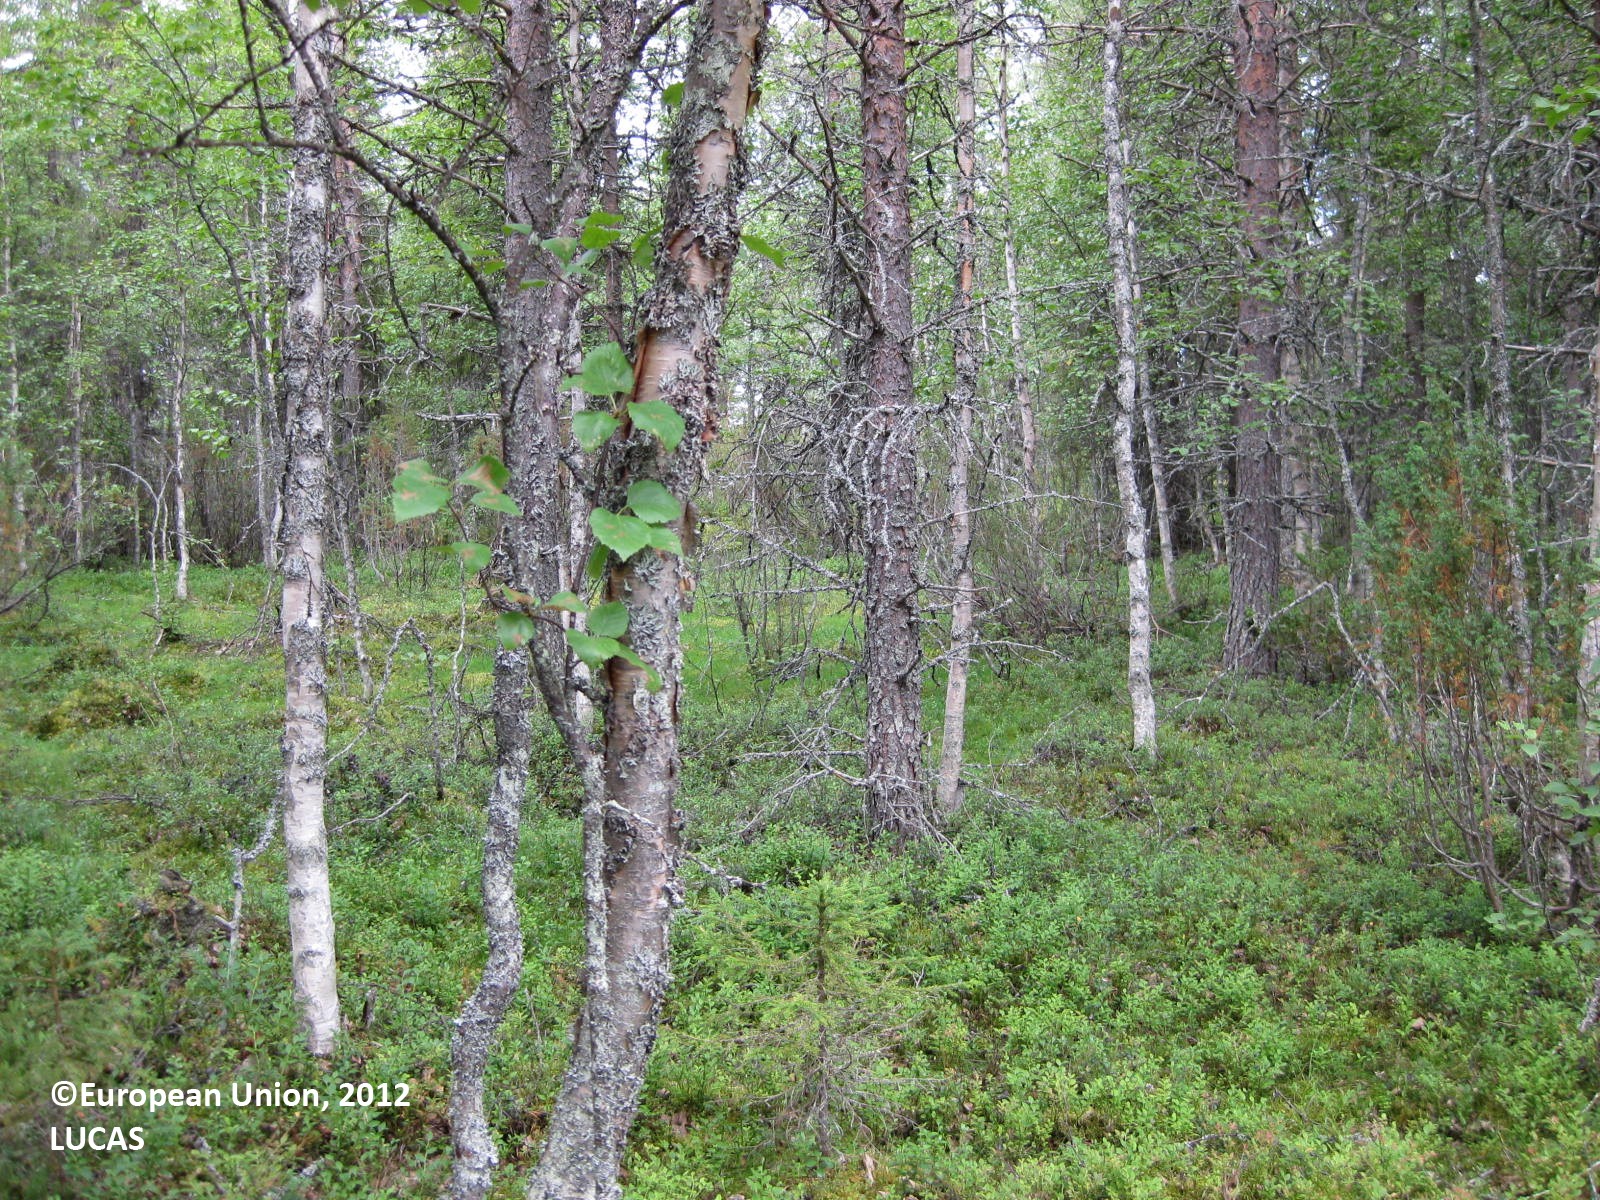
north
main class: Woodland
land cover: Other mixed woodland
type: boreal forest
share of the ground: > 75 %
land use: Forestry
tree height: > 5 m
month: August
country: FI
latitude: 66.3839
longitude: 28.4676
